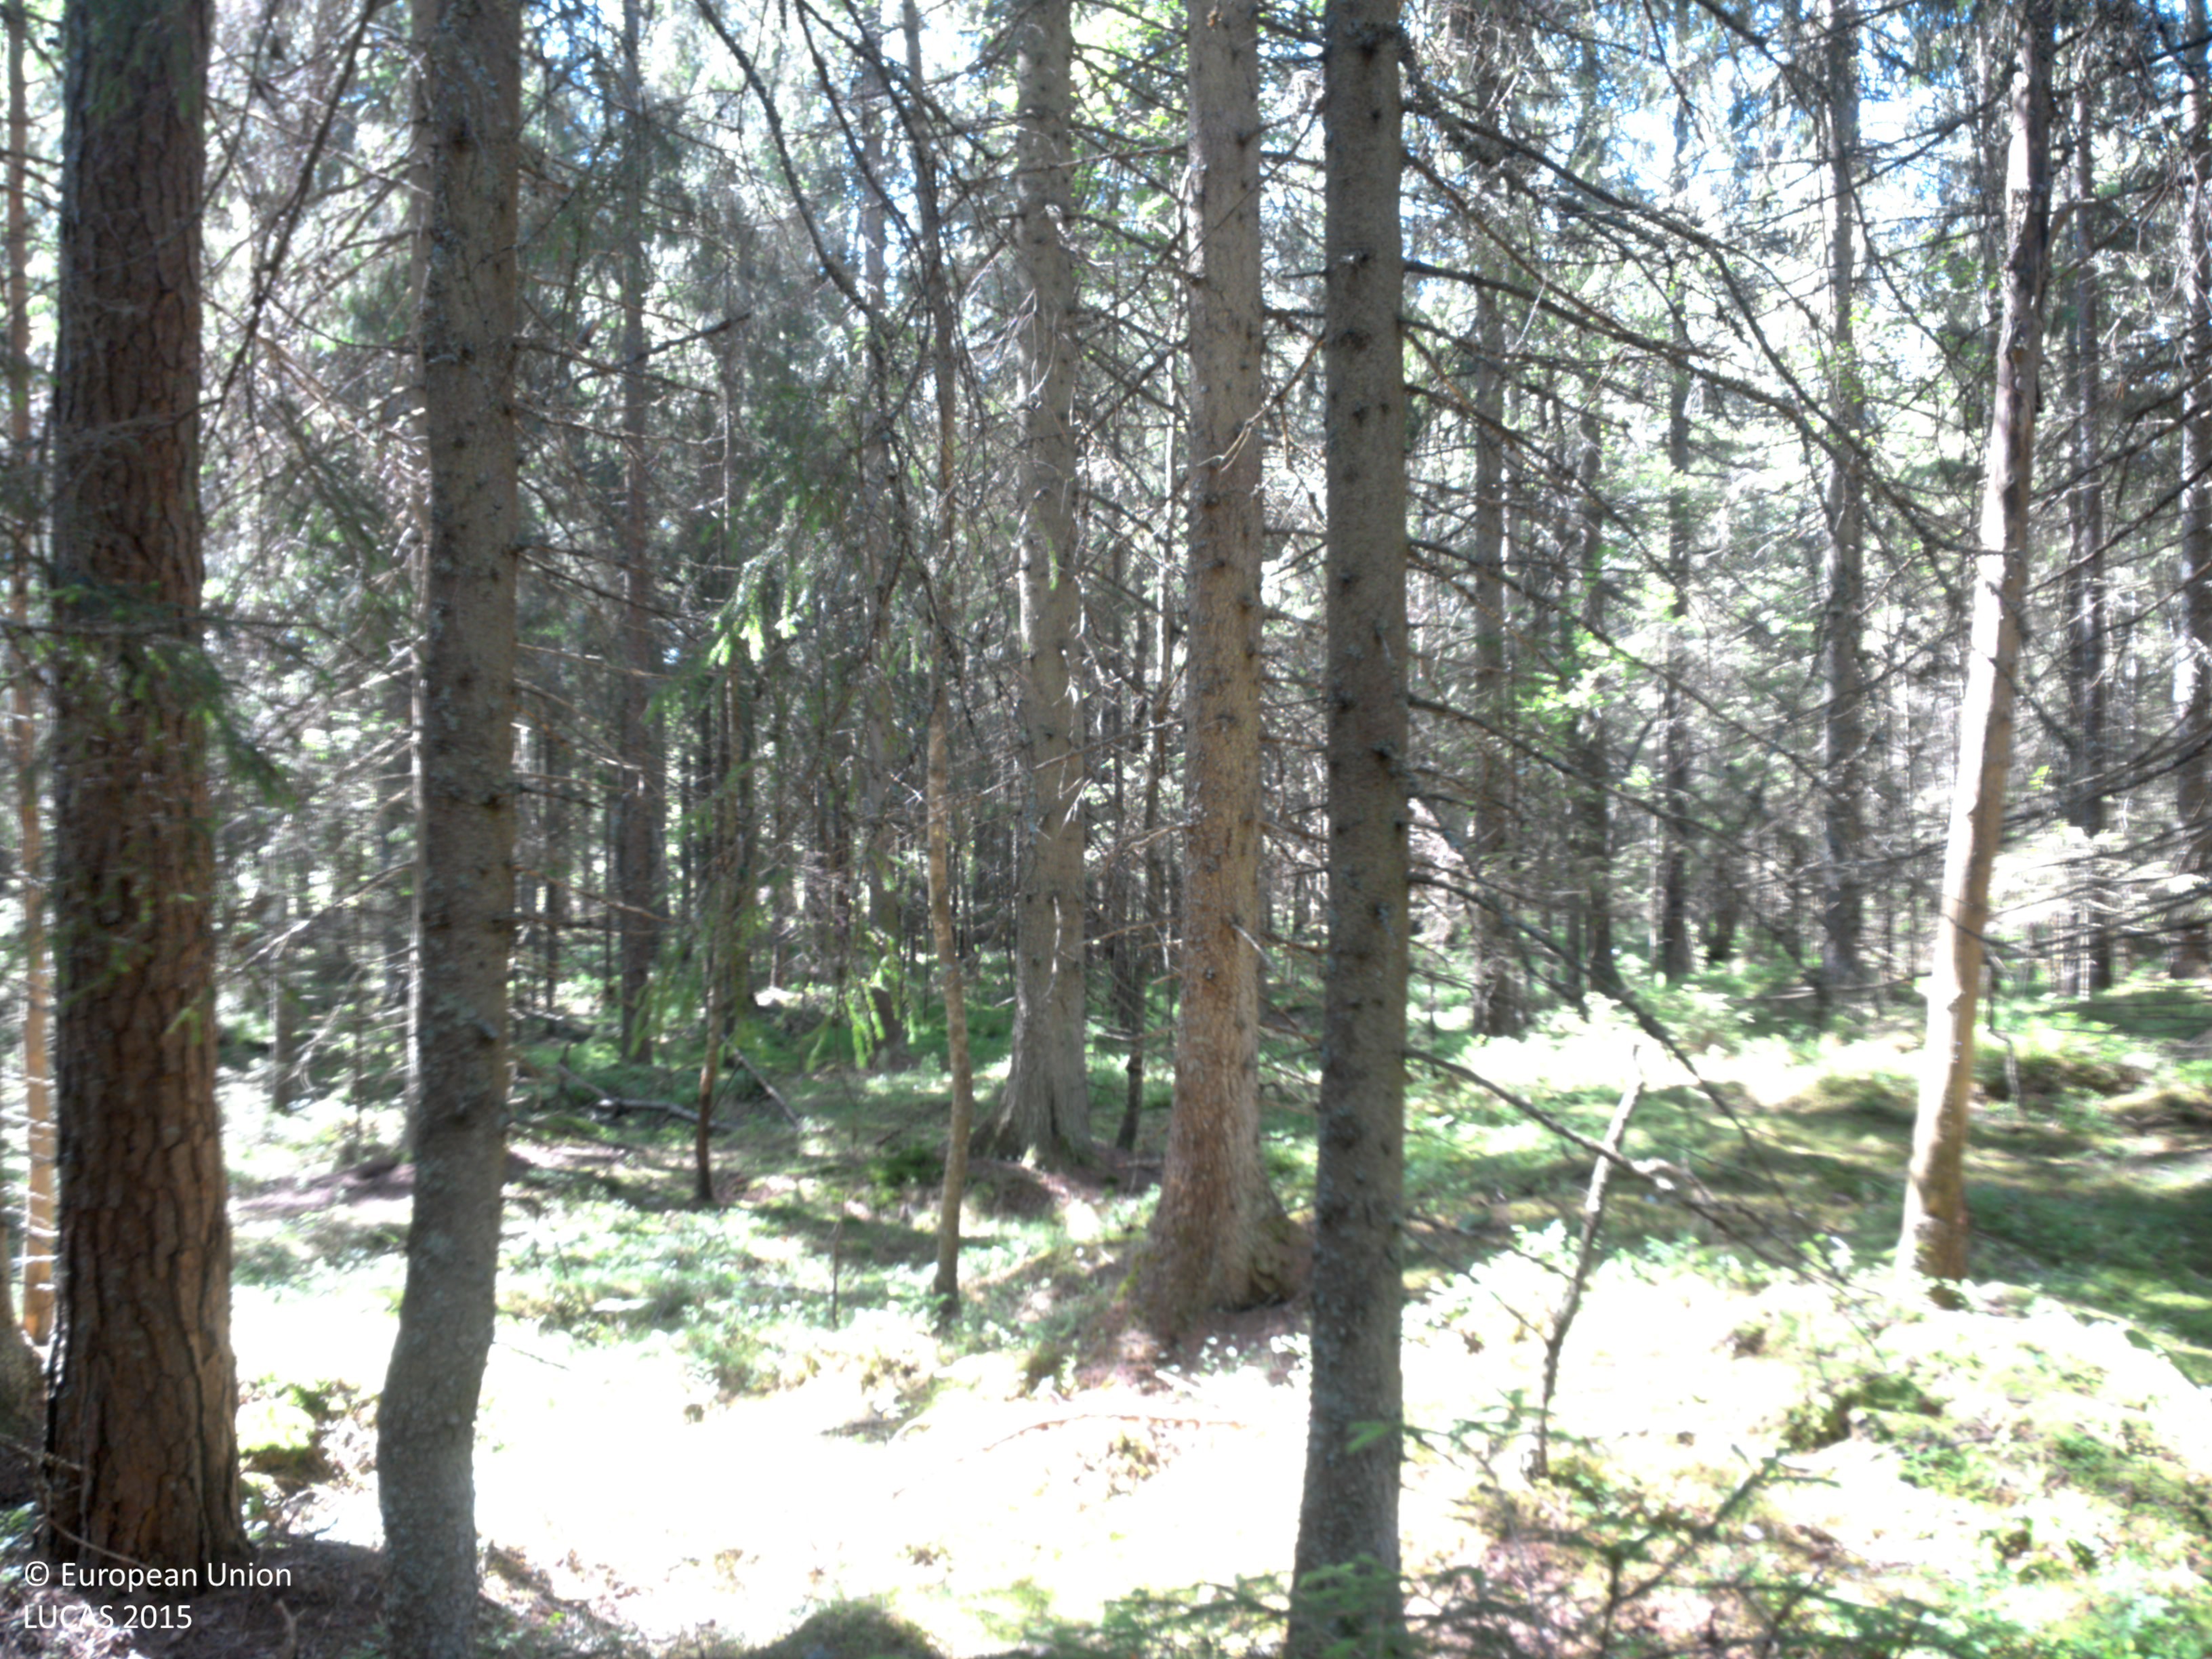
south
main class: Woodland
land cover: Spruce dominated coniferous woodland
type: boreal forest
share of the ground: 50 - 75 %
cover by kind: coniferous forest trees 75 %, lichens and mosses 25 %
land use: Forestry
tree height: > 5 m
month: July
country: SE
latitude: 58.8001
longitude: 11.8822
